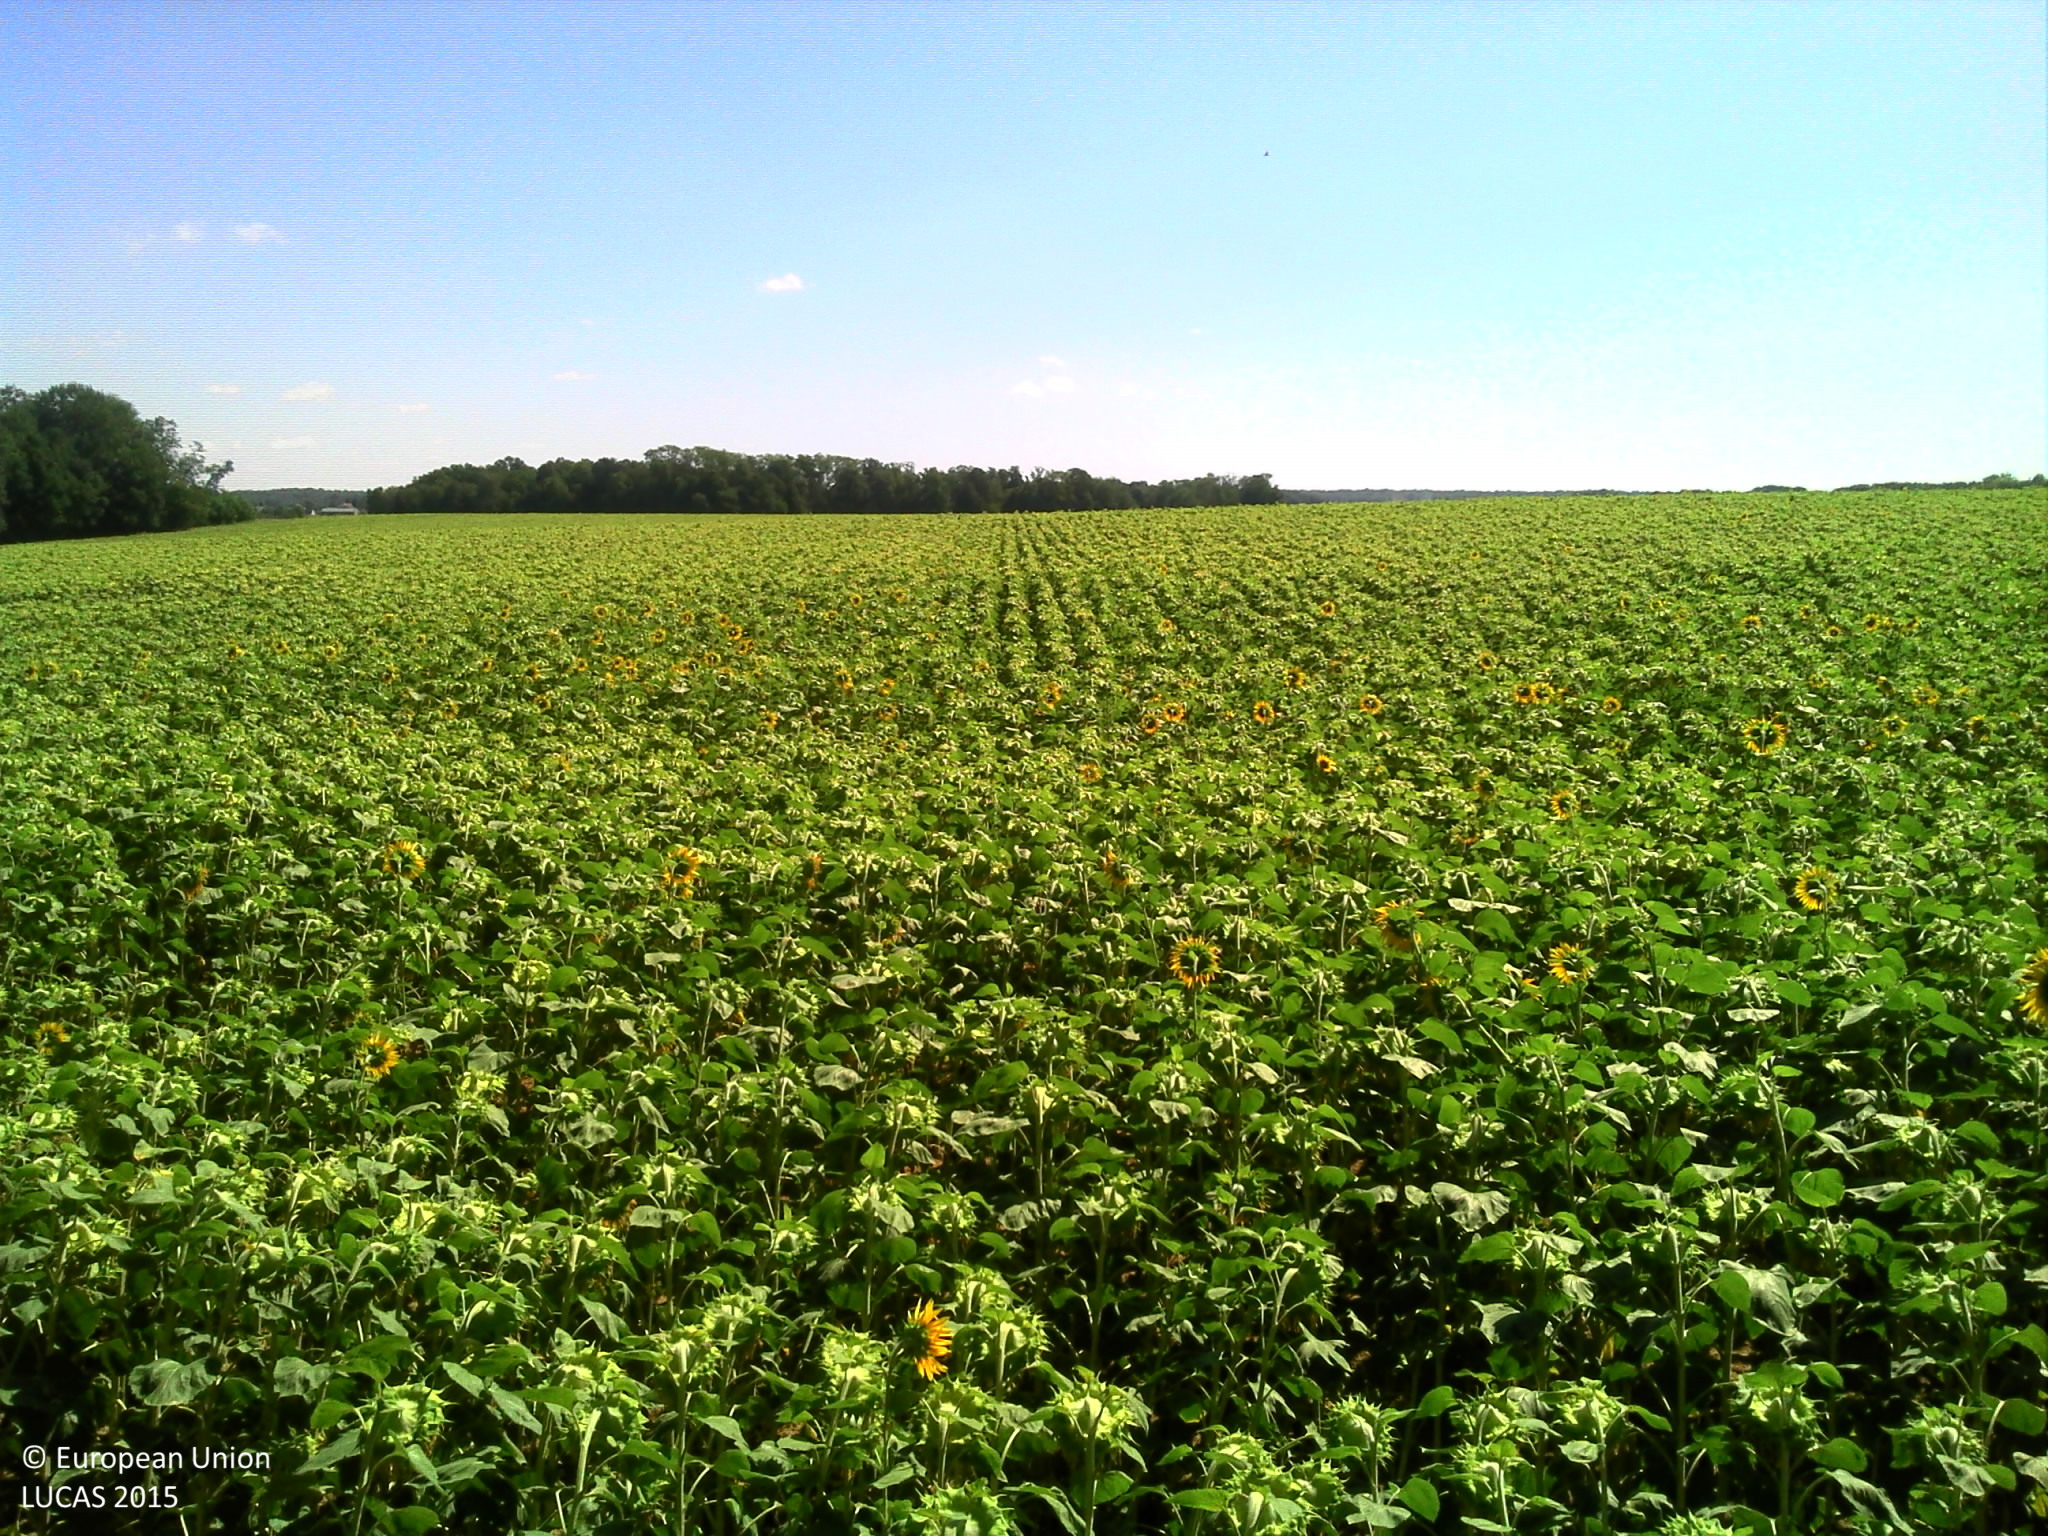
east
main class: Cropland
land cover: Sunflower
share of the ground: > 75 %
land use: Agriculture (excluding fallow land and kitchen gardens)
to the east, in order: Sunflower
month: August
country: FR
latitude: 48.7249
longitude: 3.3183
